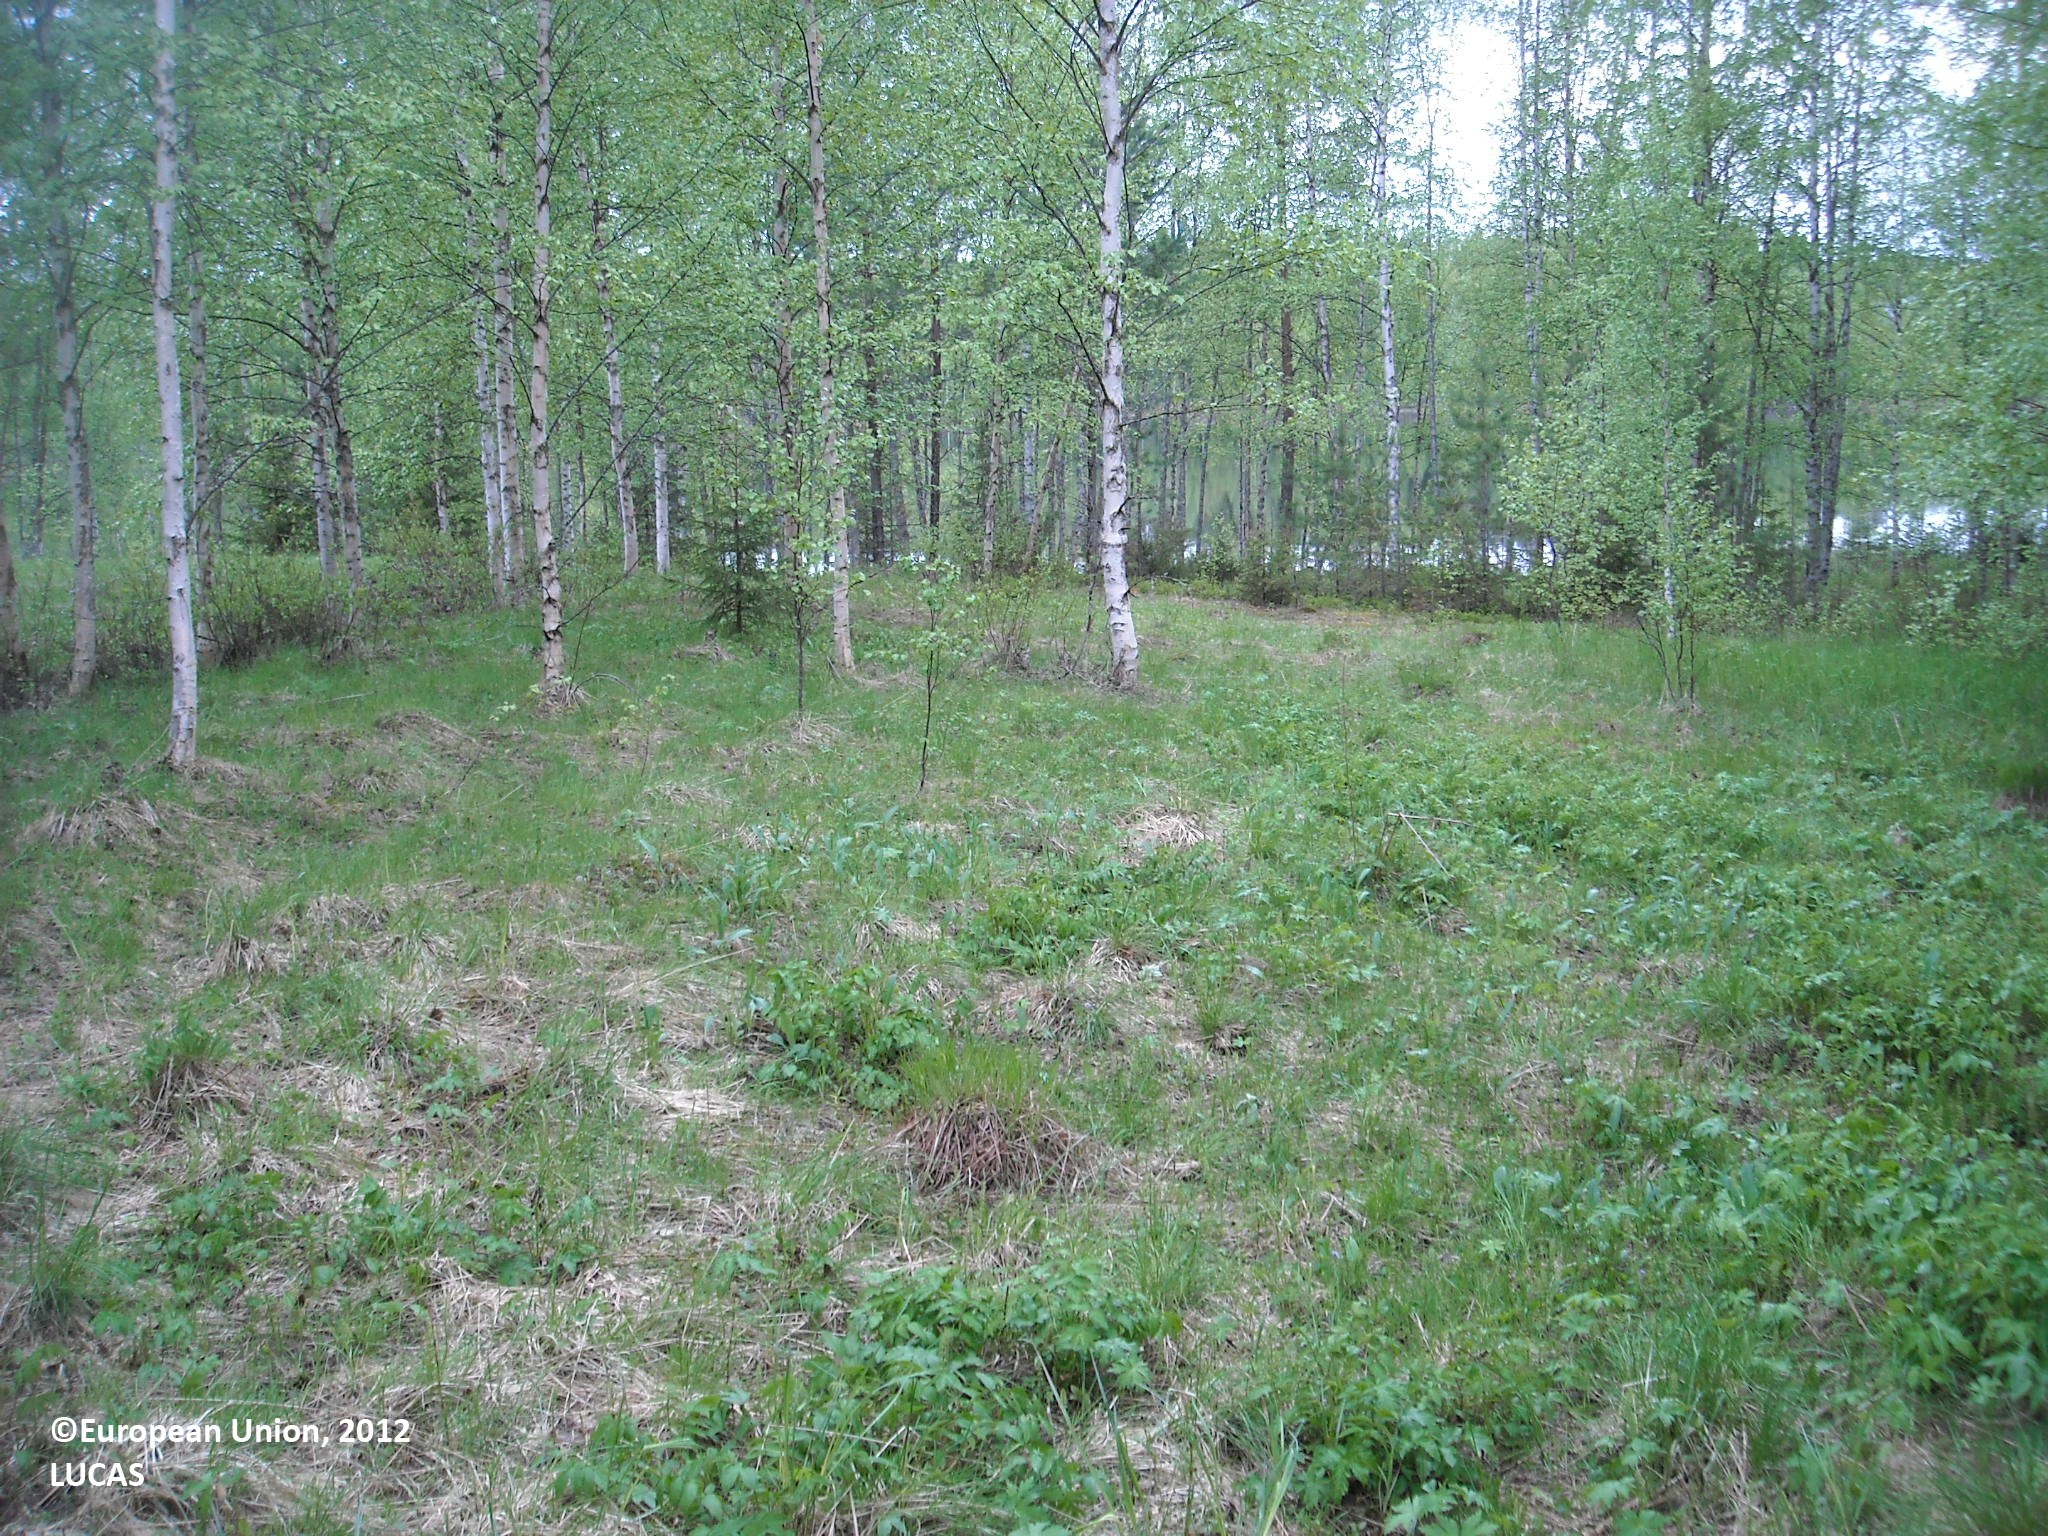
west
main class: Woodland
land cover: Broadleaved woodland
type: boreal forest
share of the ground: 10 - 25 %
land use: Semi-natural and natural areas not in use
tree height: > 5 m
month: June
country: FI
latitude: 65.2260
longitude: 27.6101
